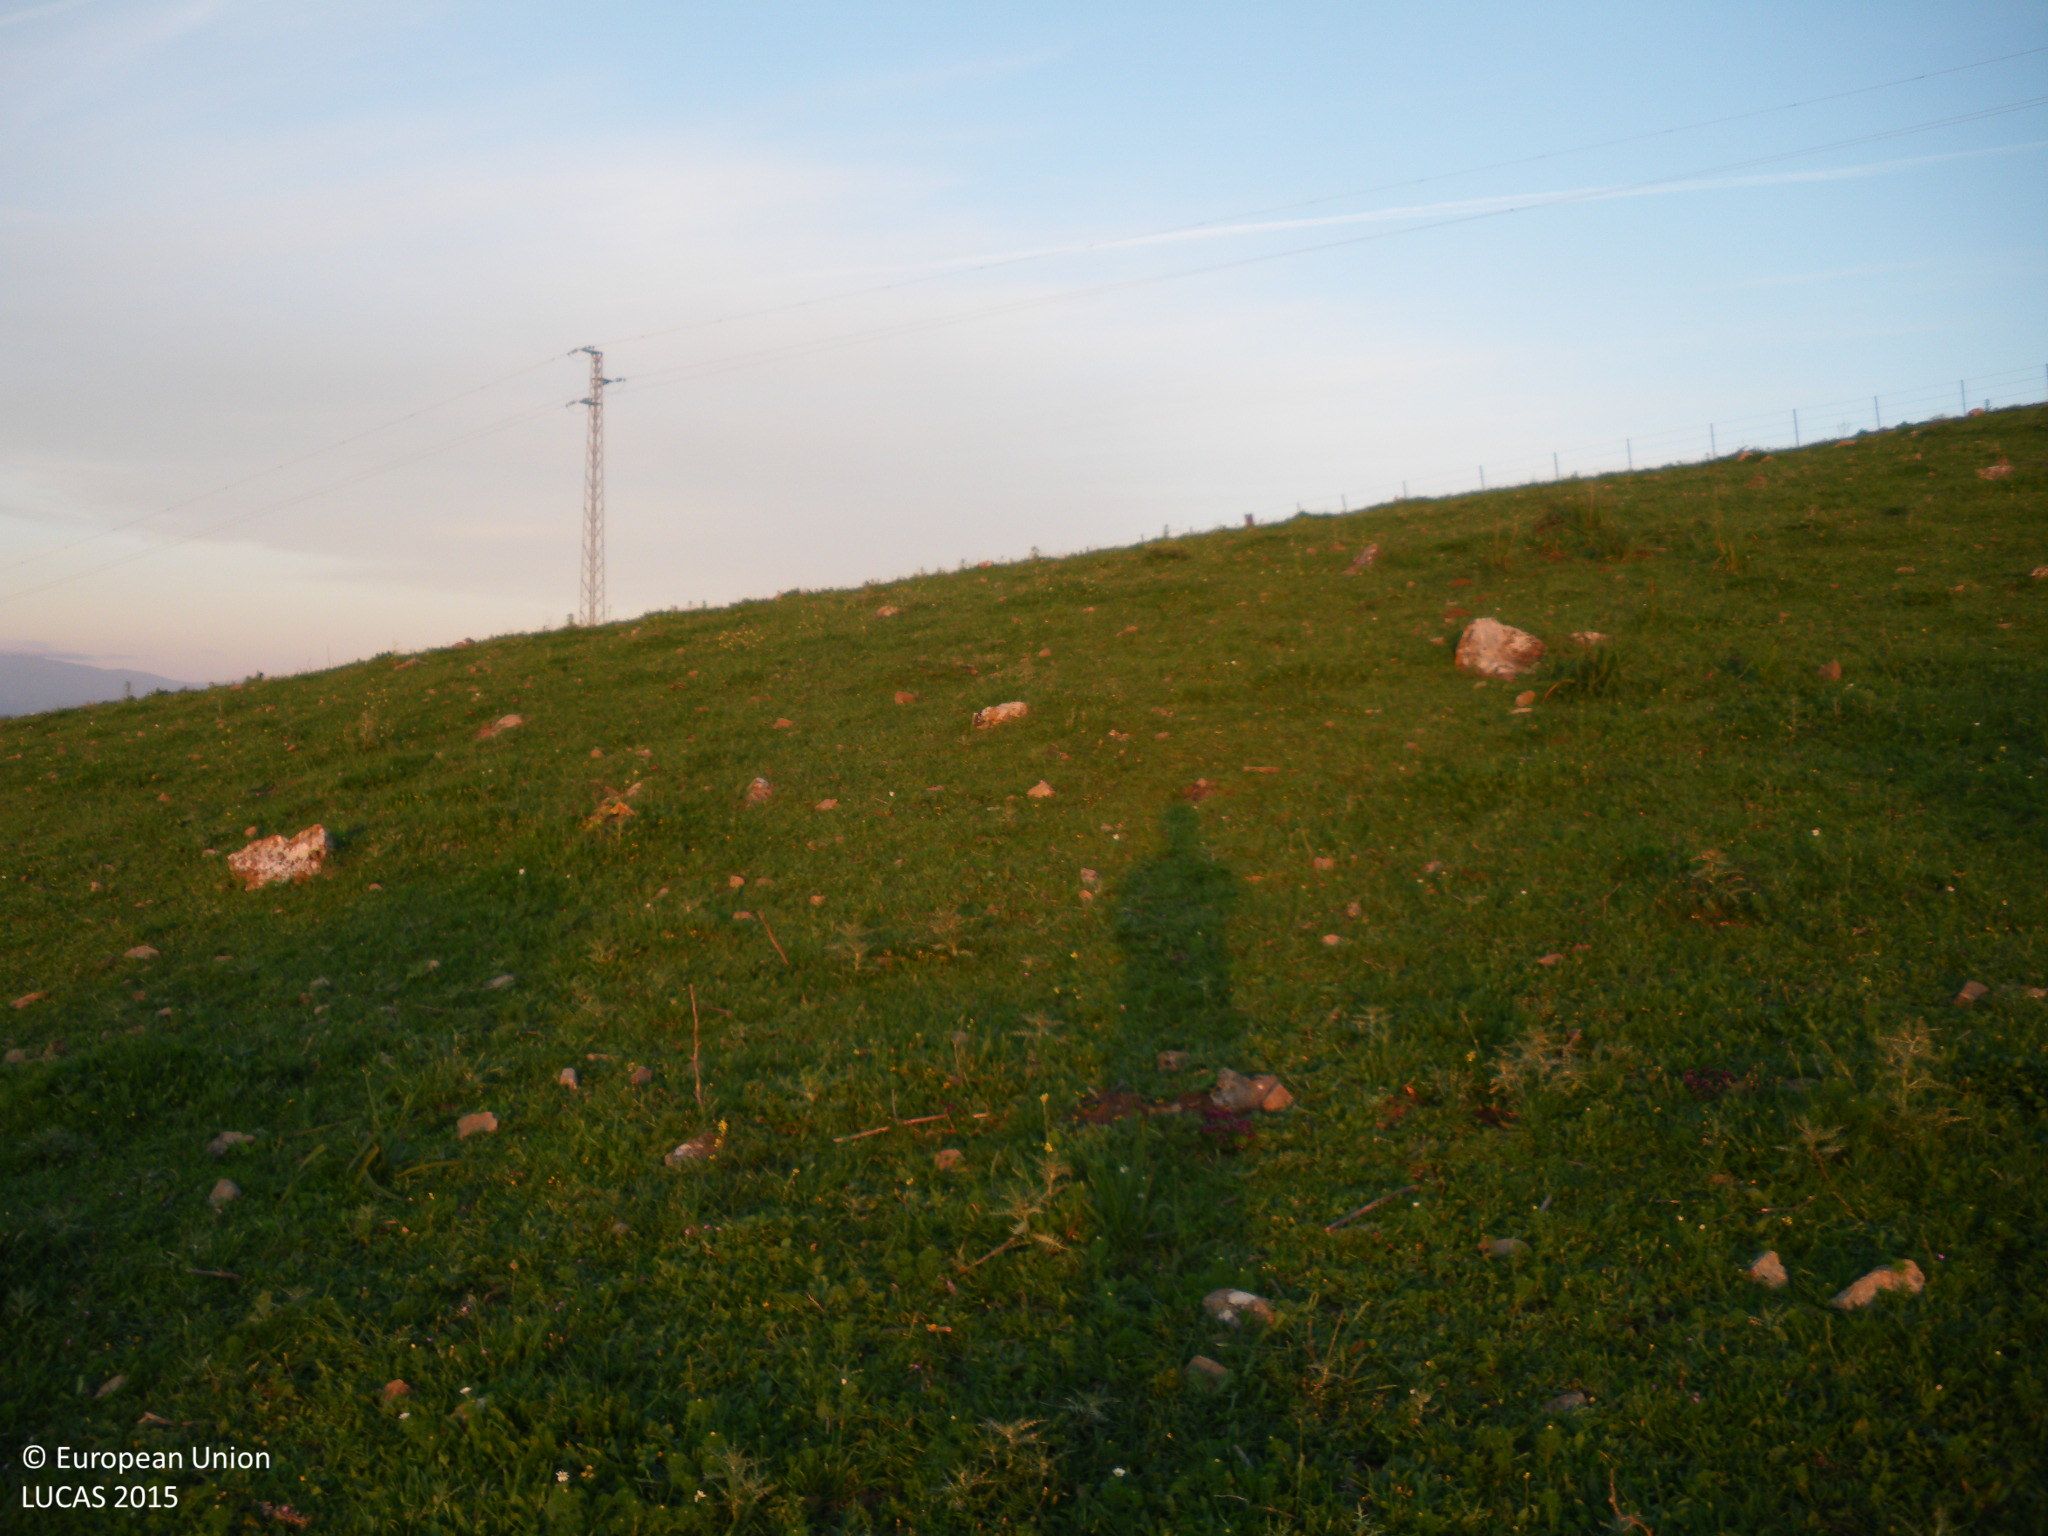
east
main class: Grassland
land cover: Grassland without tree/shrub cover
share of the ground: > 75 %
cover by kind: herbaceous plants 95 %, unconsolidated bare surface 5 %
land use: Agriculture (excluding fallow land and kitchen gardens)
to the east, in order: Grassland without tree/shrub cover; Fences; Grassland without tree/shrub cover; Electric lines; Grassland without tree/shrub cover; Fences; Grassland without tree/shrub cover
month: April
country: ES
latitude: 36.4299
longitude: -5.9436
